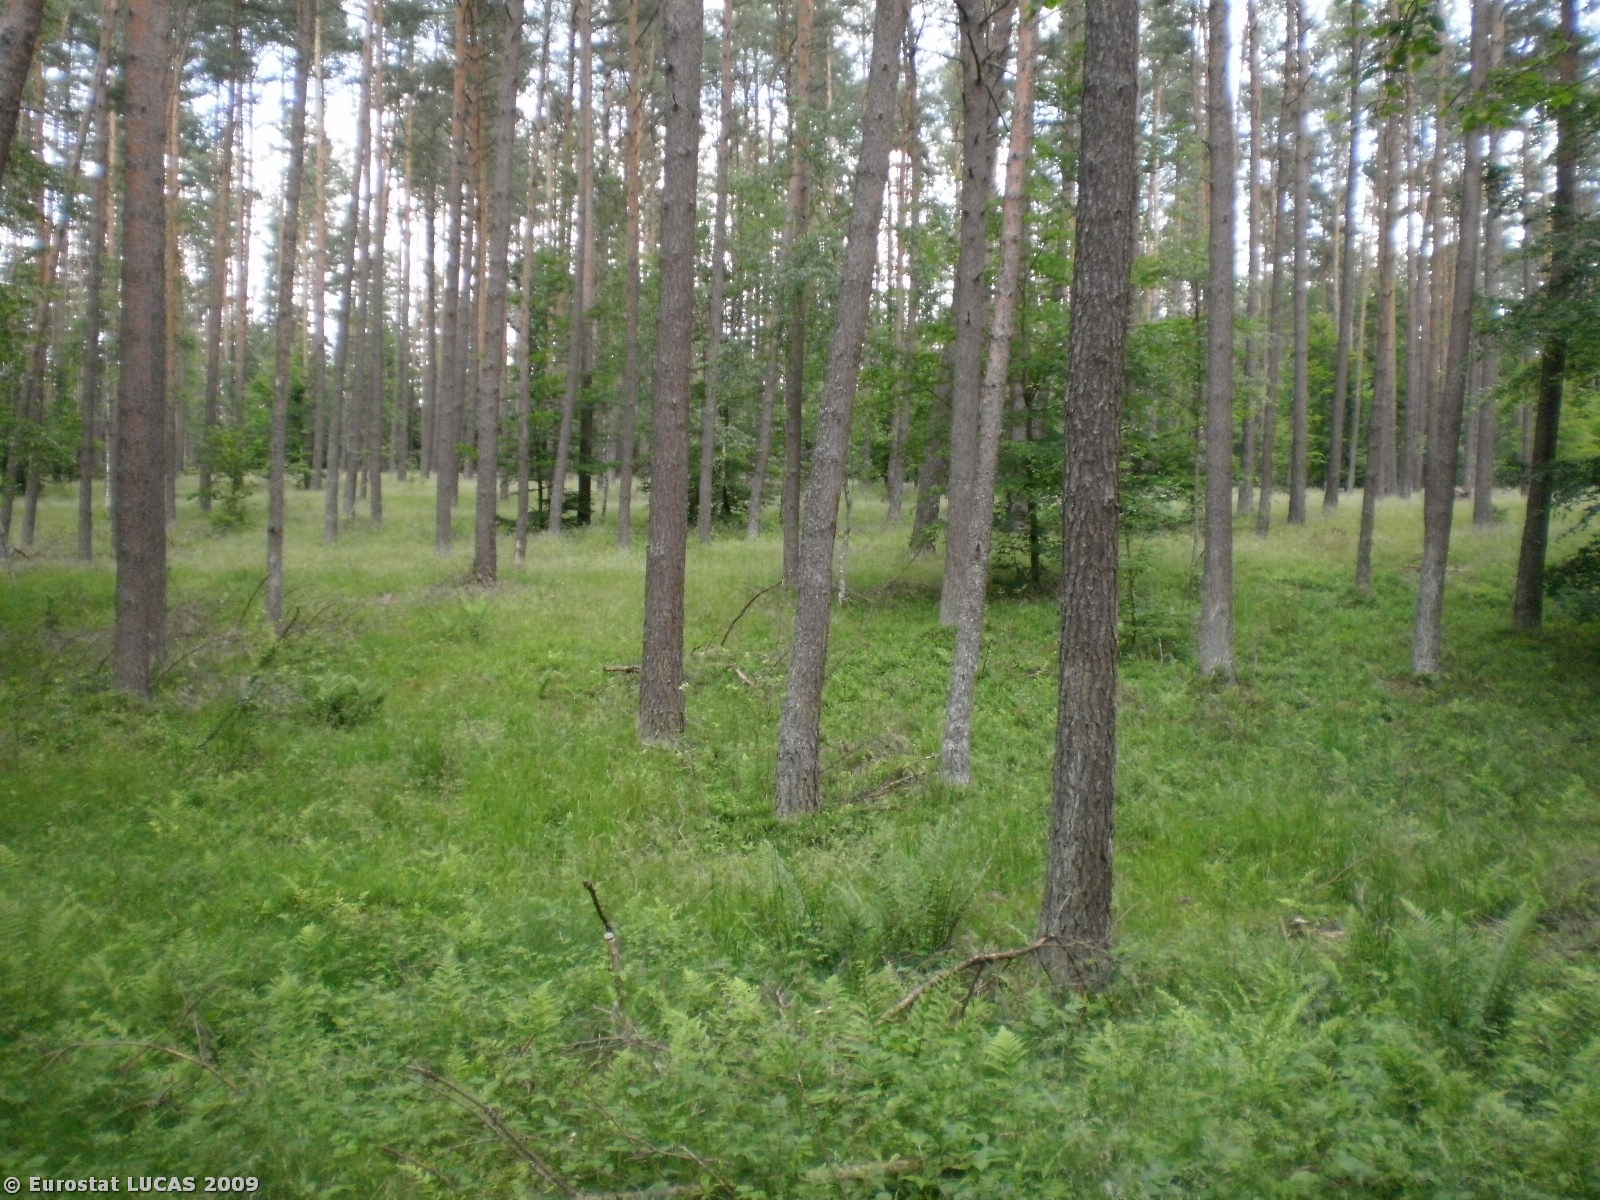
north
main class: Woodland
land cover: Coniferous woodland
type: hemiboreal forest and nemoral coniferous forest and mixed broadleaved-coniferous forest
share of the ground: > 75 %
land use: Forestry
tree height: > 5 m
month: June
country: PL
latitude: 53.7584
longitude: 19.8740
